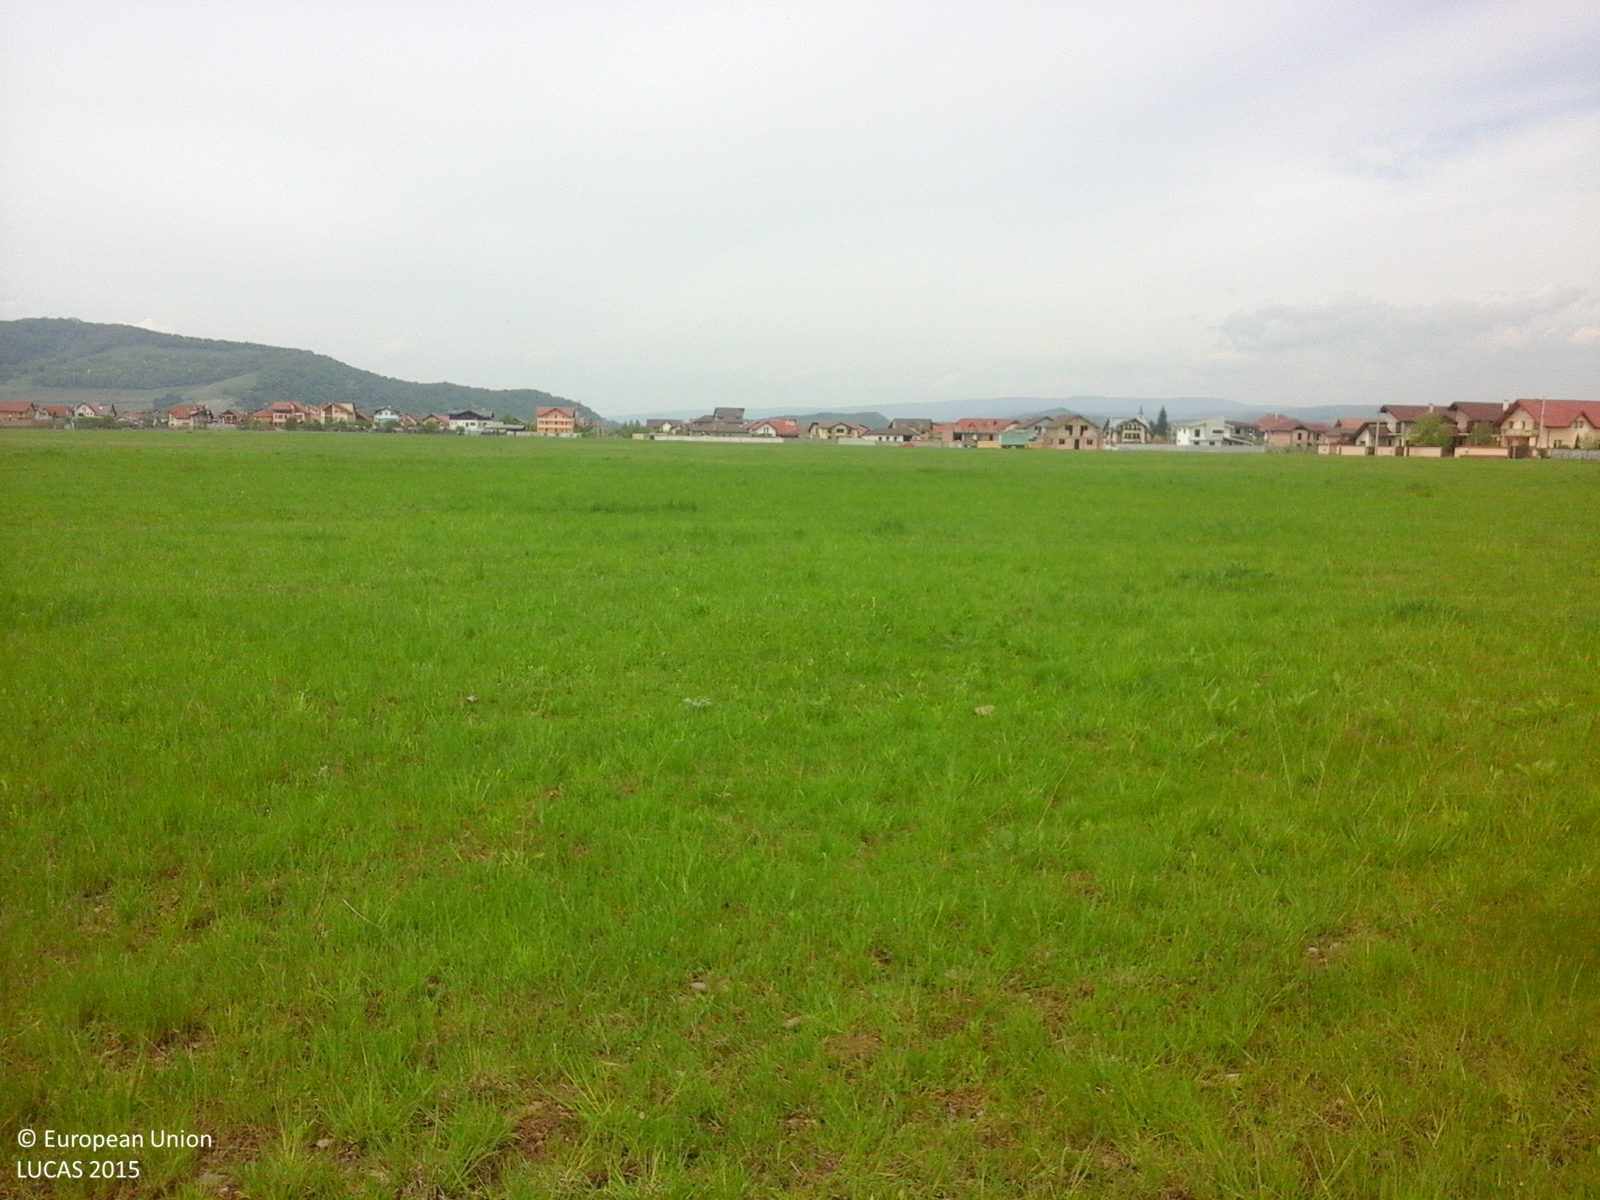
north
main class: Grassland
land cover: Grassland without tree/shrub cover
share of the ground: > 75 %
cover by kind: herbaceous plants 100 %
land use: Agriculture (excluding fallow land and kitchen gardens)
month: May
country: RO
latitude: 45.6983
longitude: 25.6852
